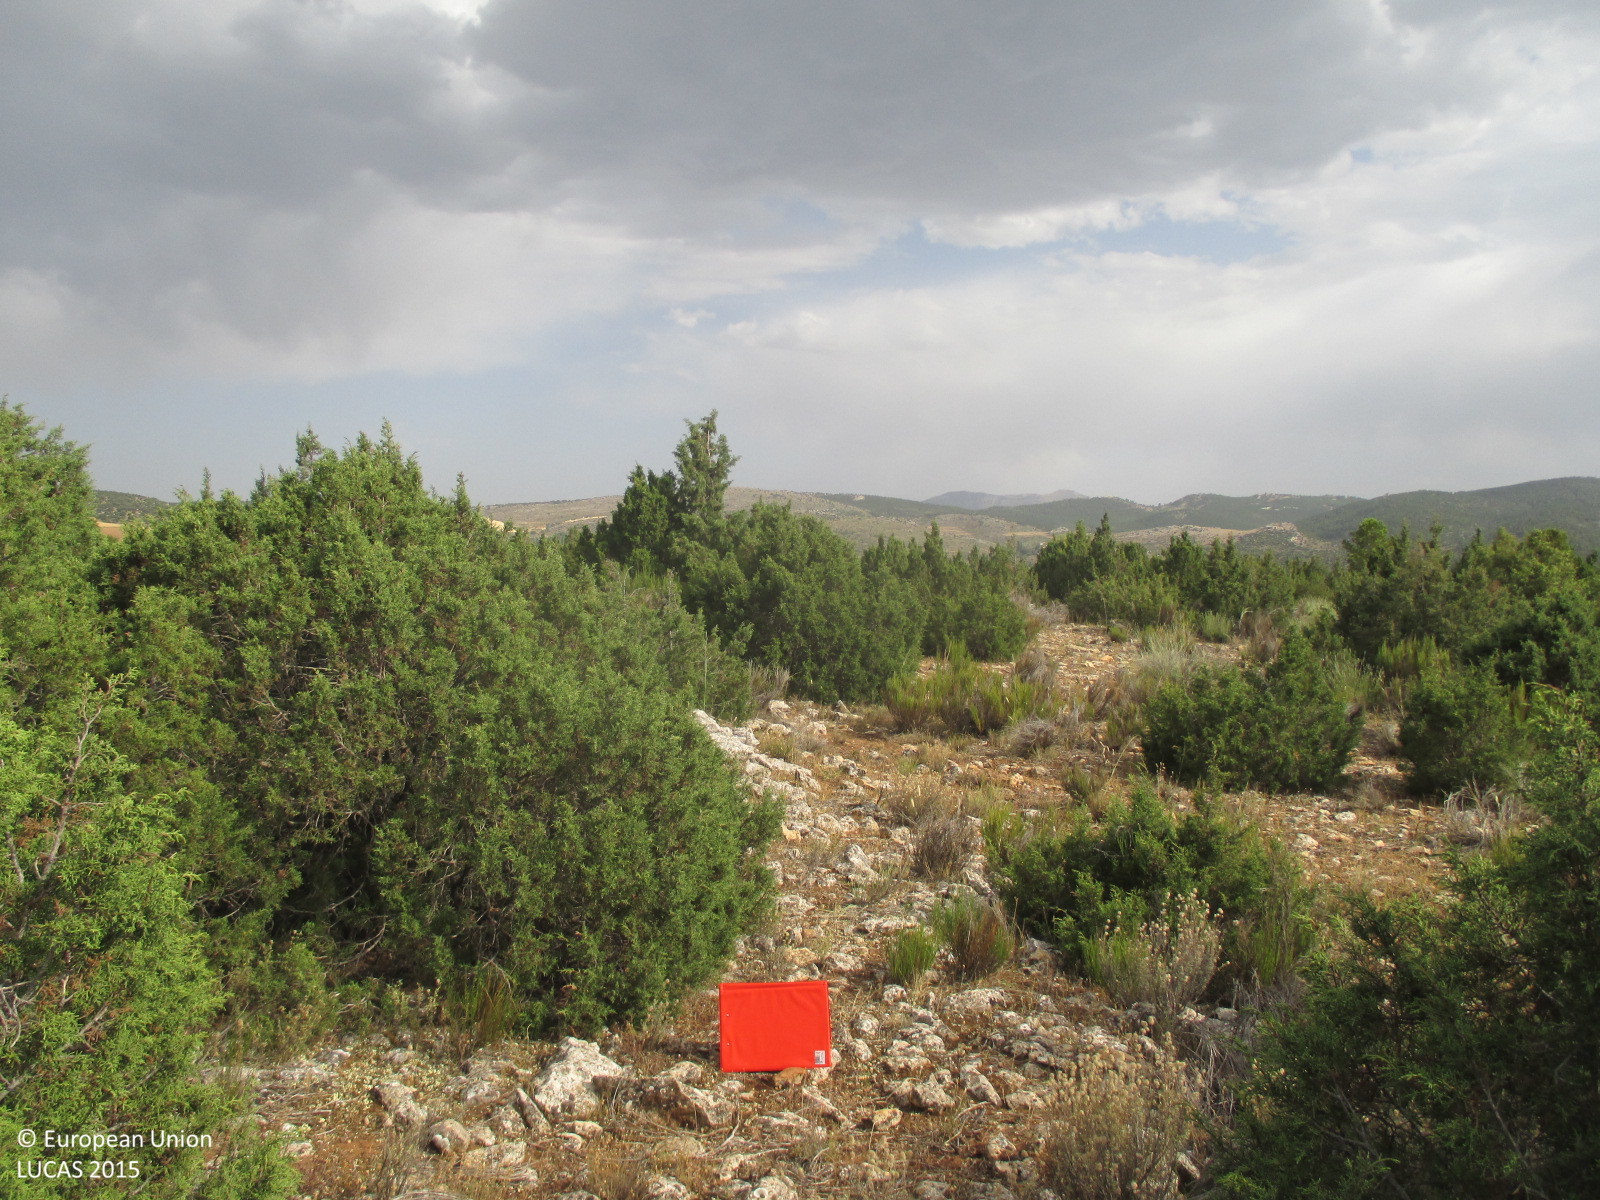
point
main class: Shrubland
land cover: Shrubland without tree cover
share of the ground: 50 - 75 %
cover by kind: shrubs 50 %, herbaceous plants 30 %, consolidated bare surface 20 %
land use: Semi-natural and natural areas not in use
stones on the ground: < 10 %
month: July
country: ES
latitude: 38.1929
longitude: -2.4285
